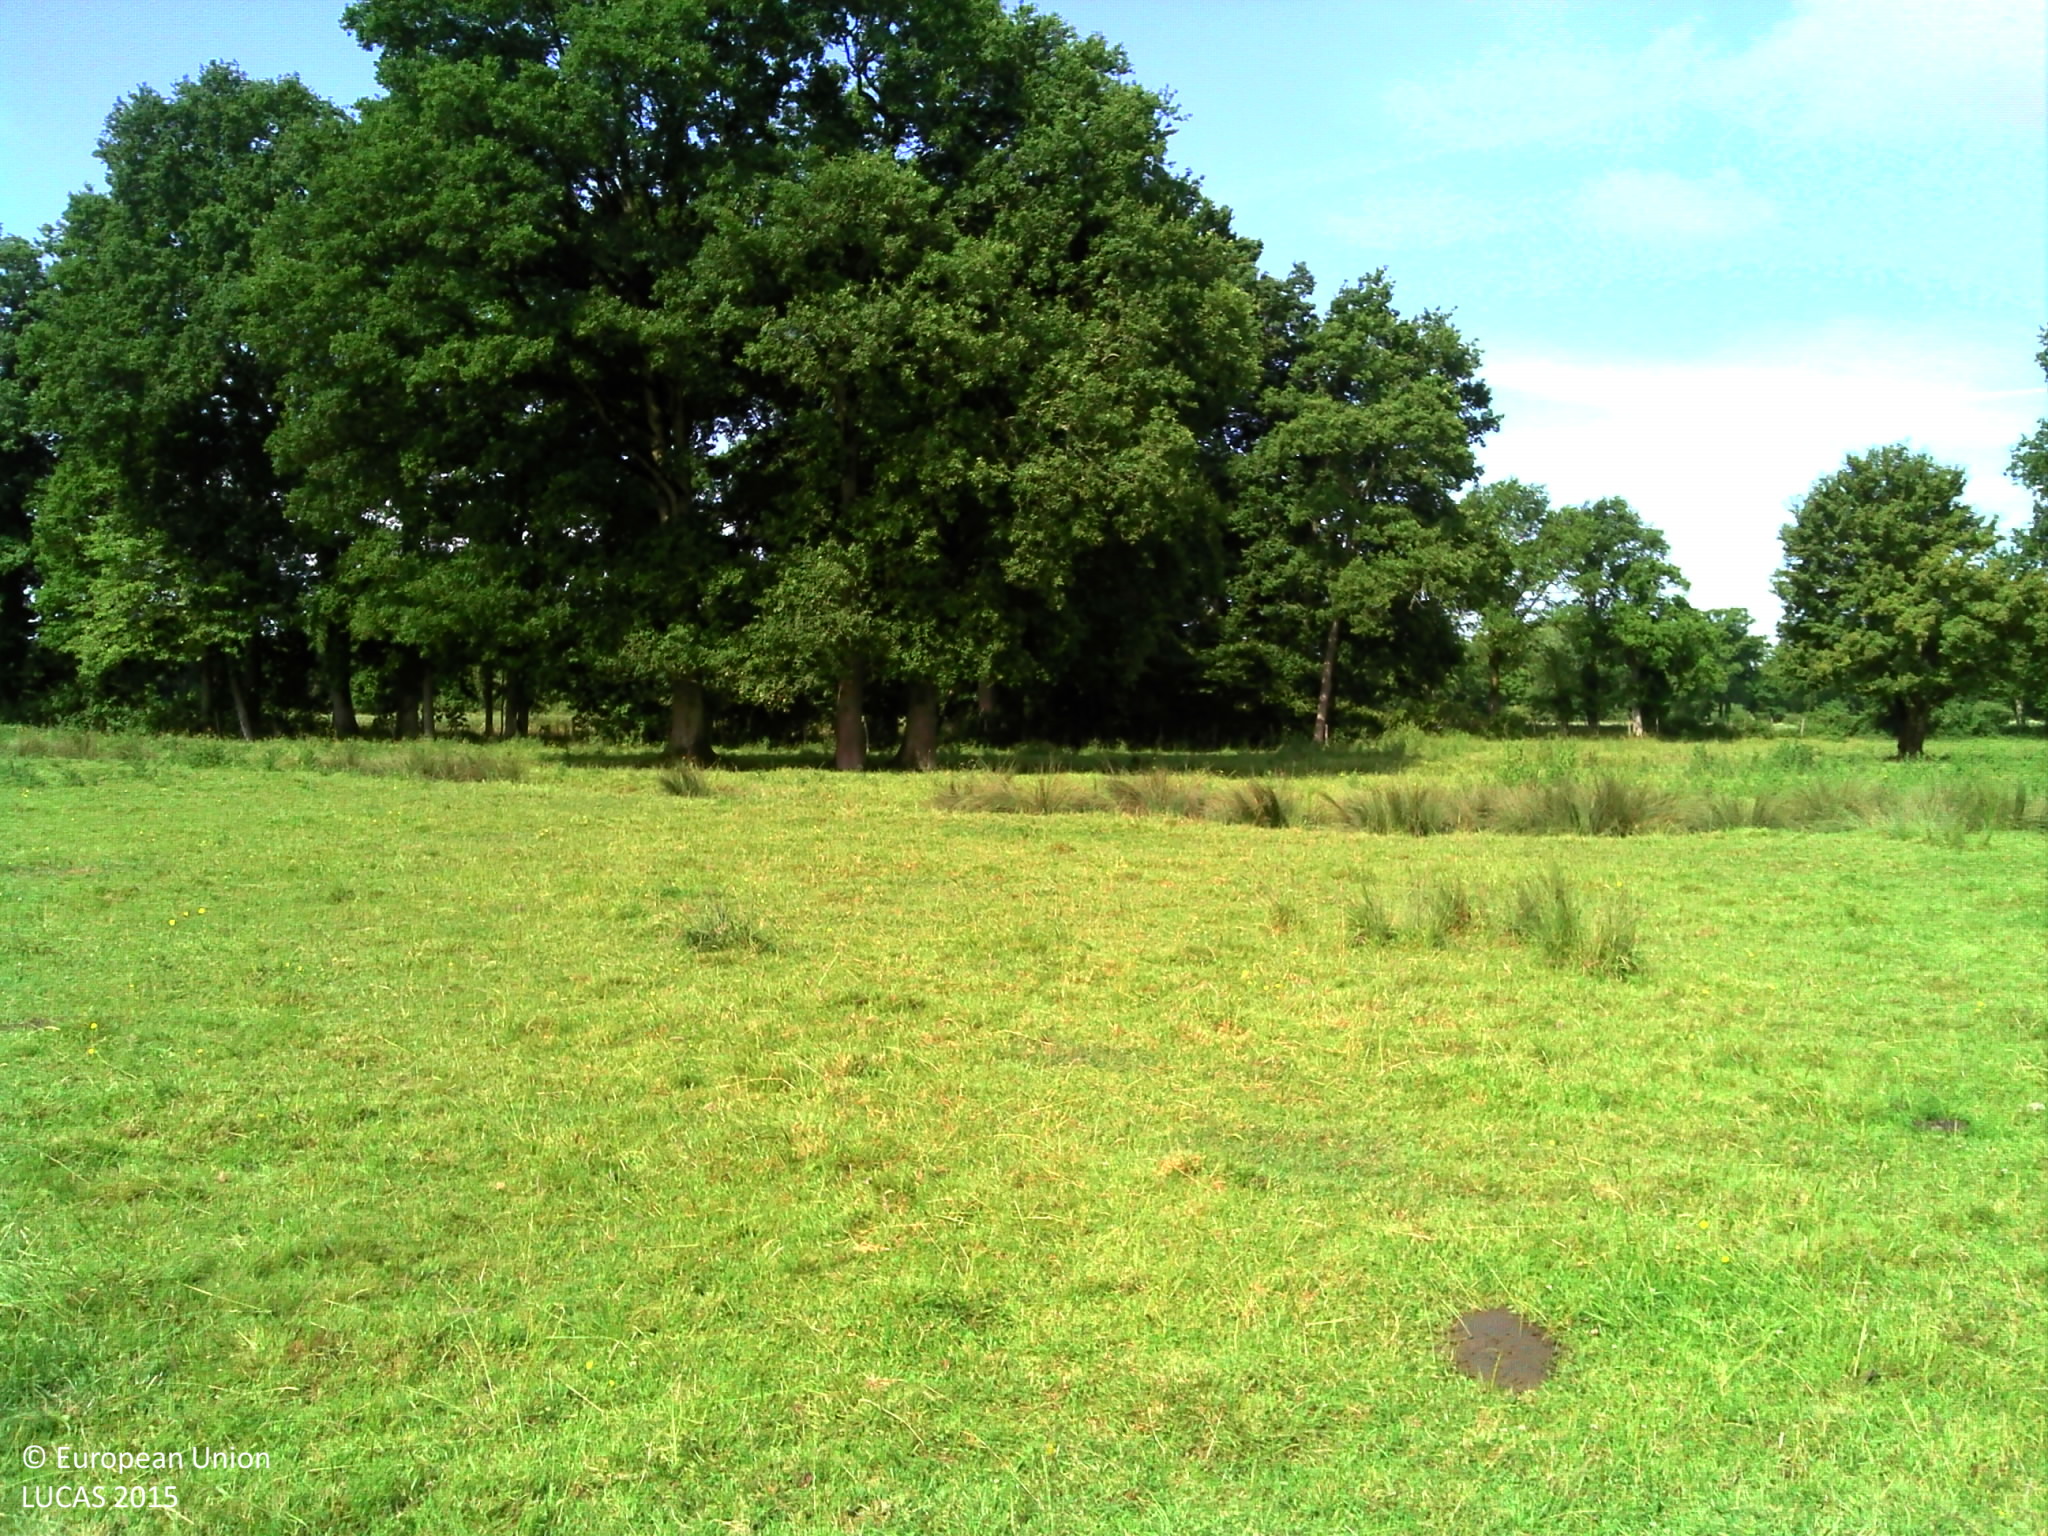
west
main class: Grassland
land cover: Grassland without tree/shrub cover
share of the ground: > 75 %
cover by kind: herbaceous plants 100 %
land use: Agriculture (excluding fallow land and kitchen gardens)
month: June
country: FR
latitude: 48.2902
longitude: -1.5165
